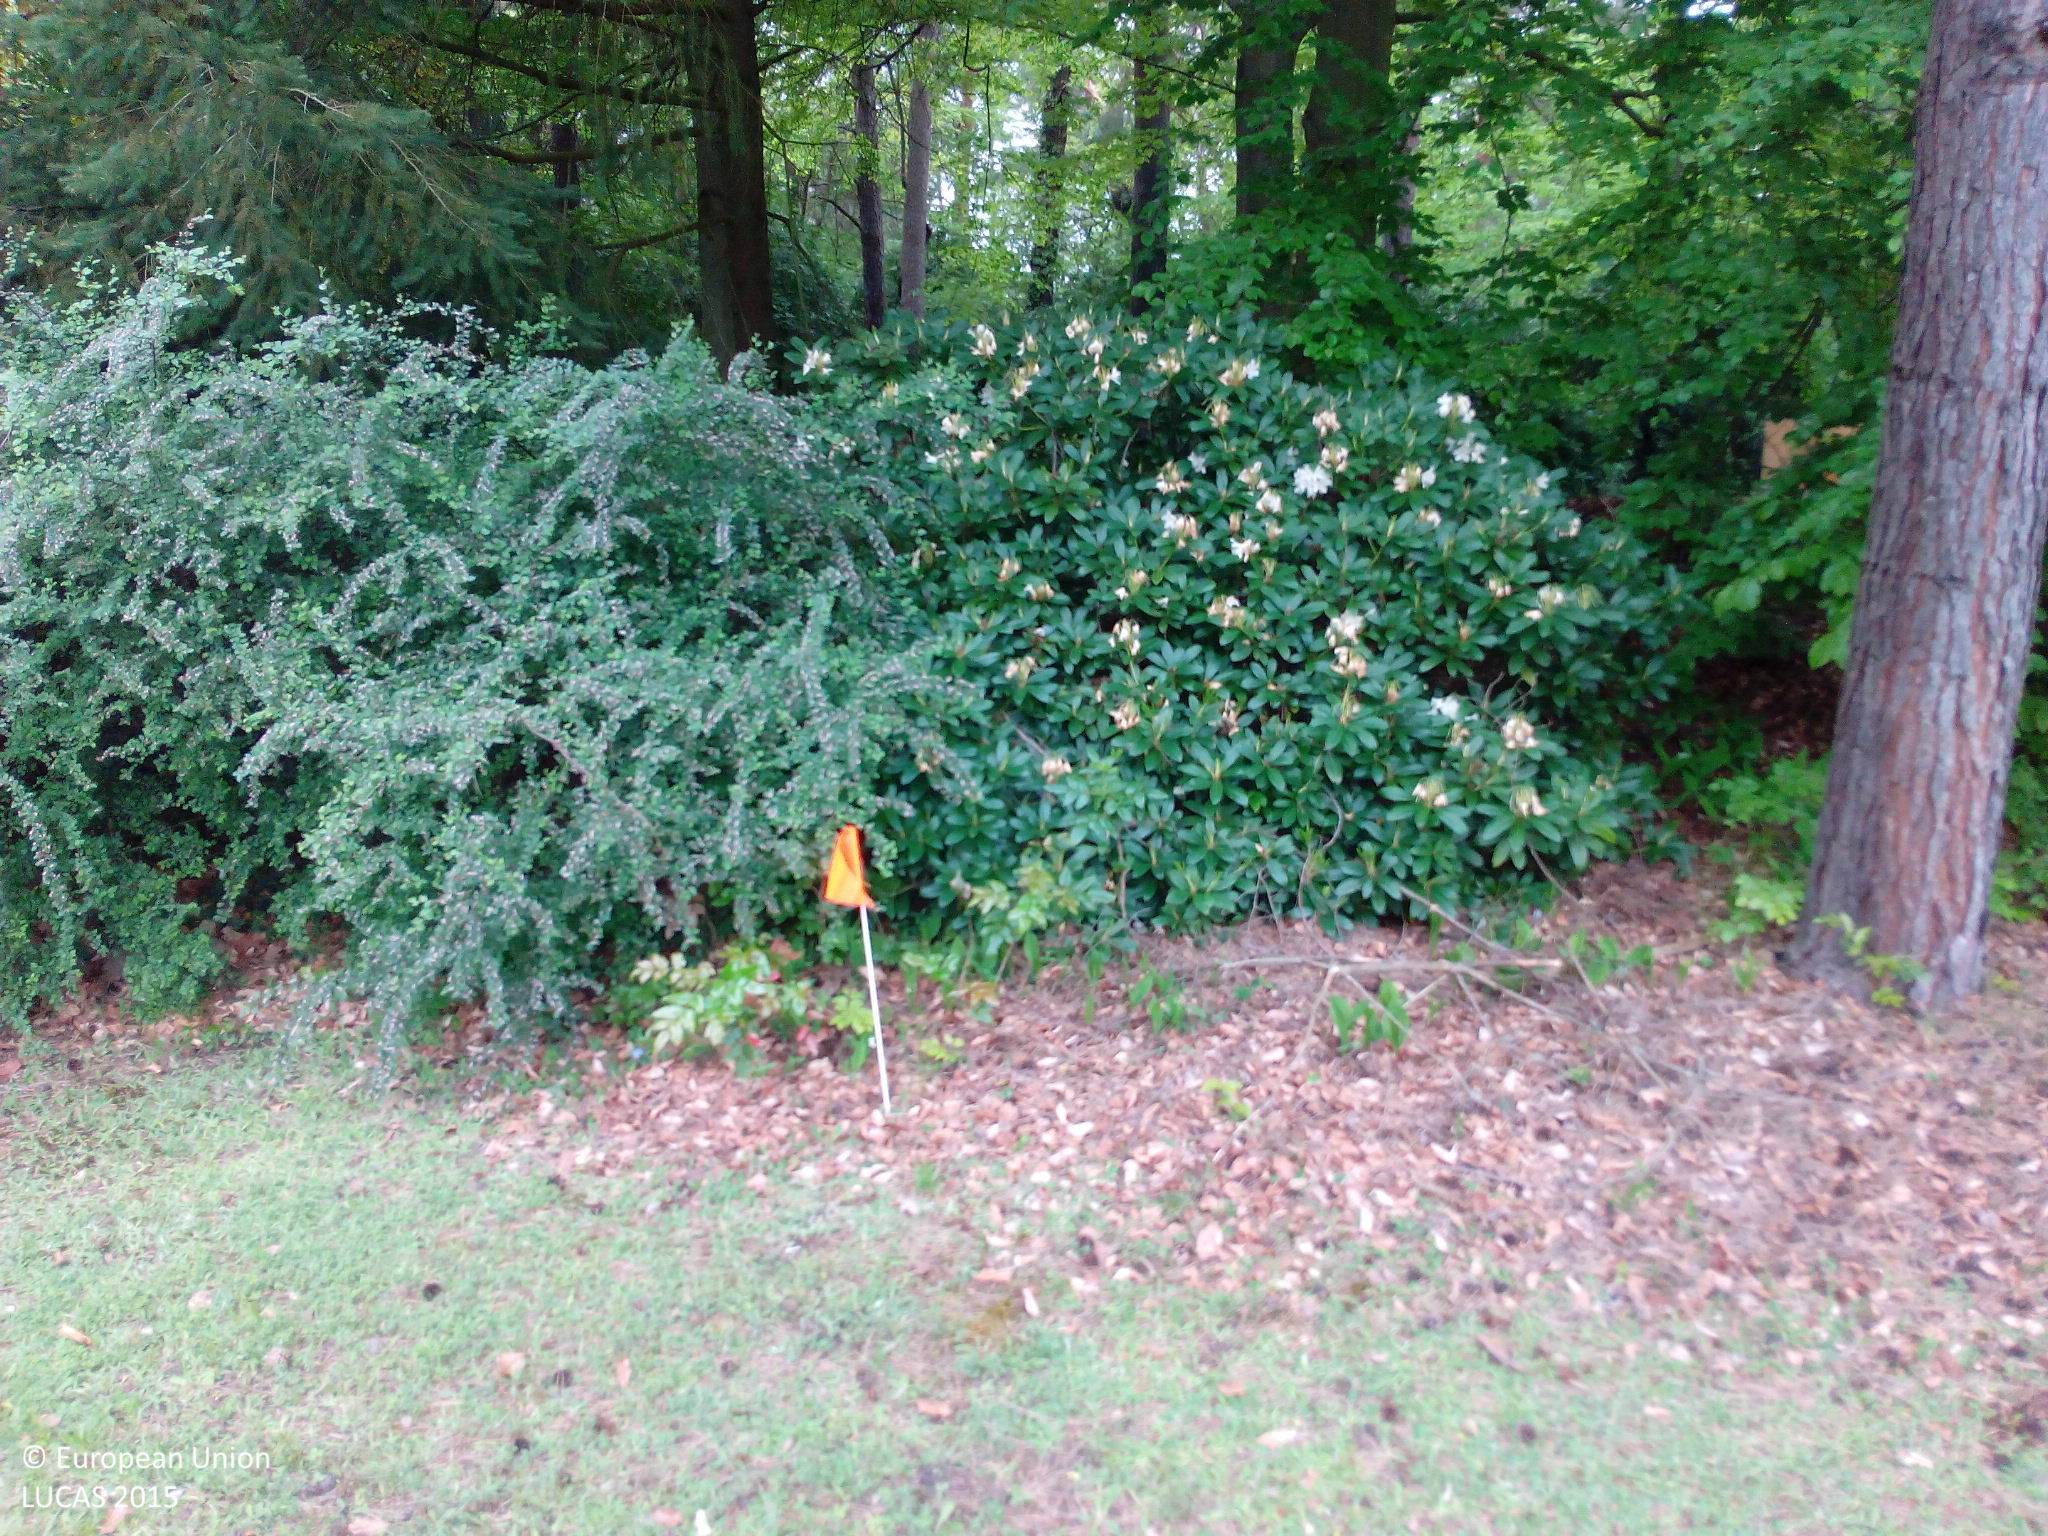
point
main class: Woodland
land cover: Broadleaved woodland
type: mesophytic deciduous forest
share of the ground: 50 - 75 %
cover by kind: broadleaved forest trees 60 %, shrubs 20 %, herbaceous plants 10 %, consolidated bare surface 10 %
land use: Community services
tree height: > 5 m
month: May
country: DE
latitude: 52.3887
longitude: 13.1885
